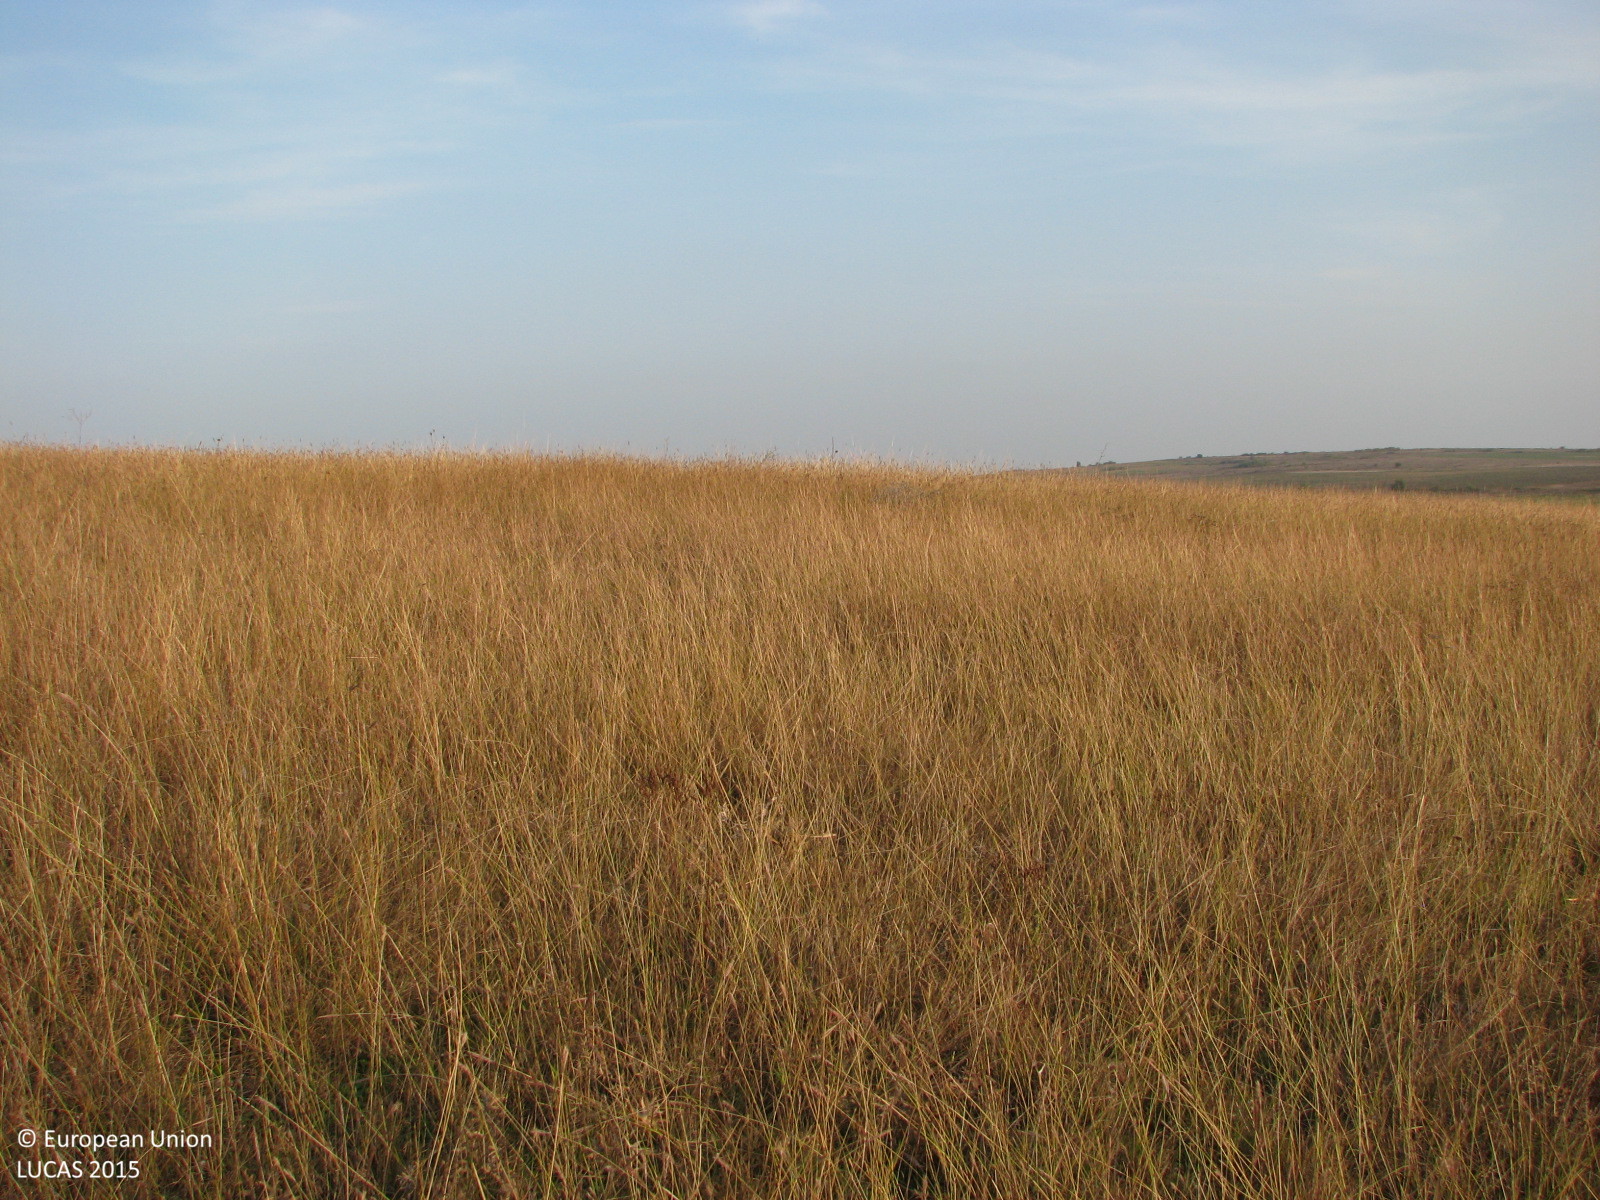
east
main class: Grassland
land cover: Grassland without tree/shrub cover
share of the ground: > 75 %
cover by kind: herbaceous plants 100 %
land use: Agriculture (excluding fallow land and kitchen gardens)
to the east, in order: Grassland without tree/shrub cover; Rivers and streams; Grassland without tree/shrub cover
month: October
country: BG
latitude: 42.2954
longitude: 26.4257
